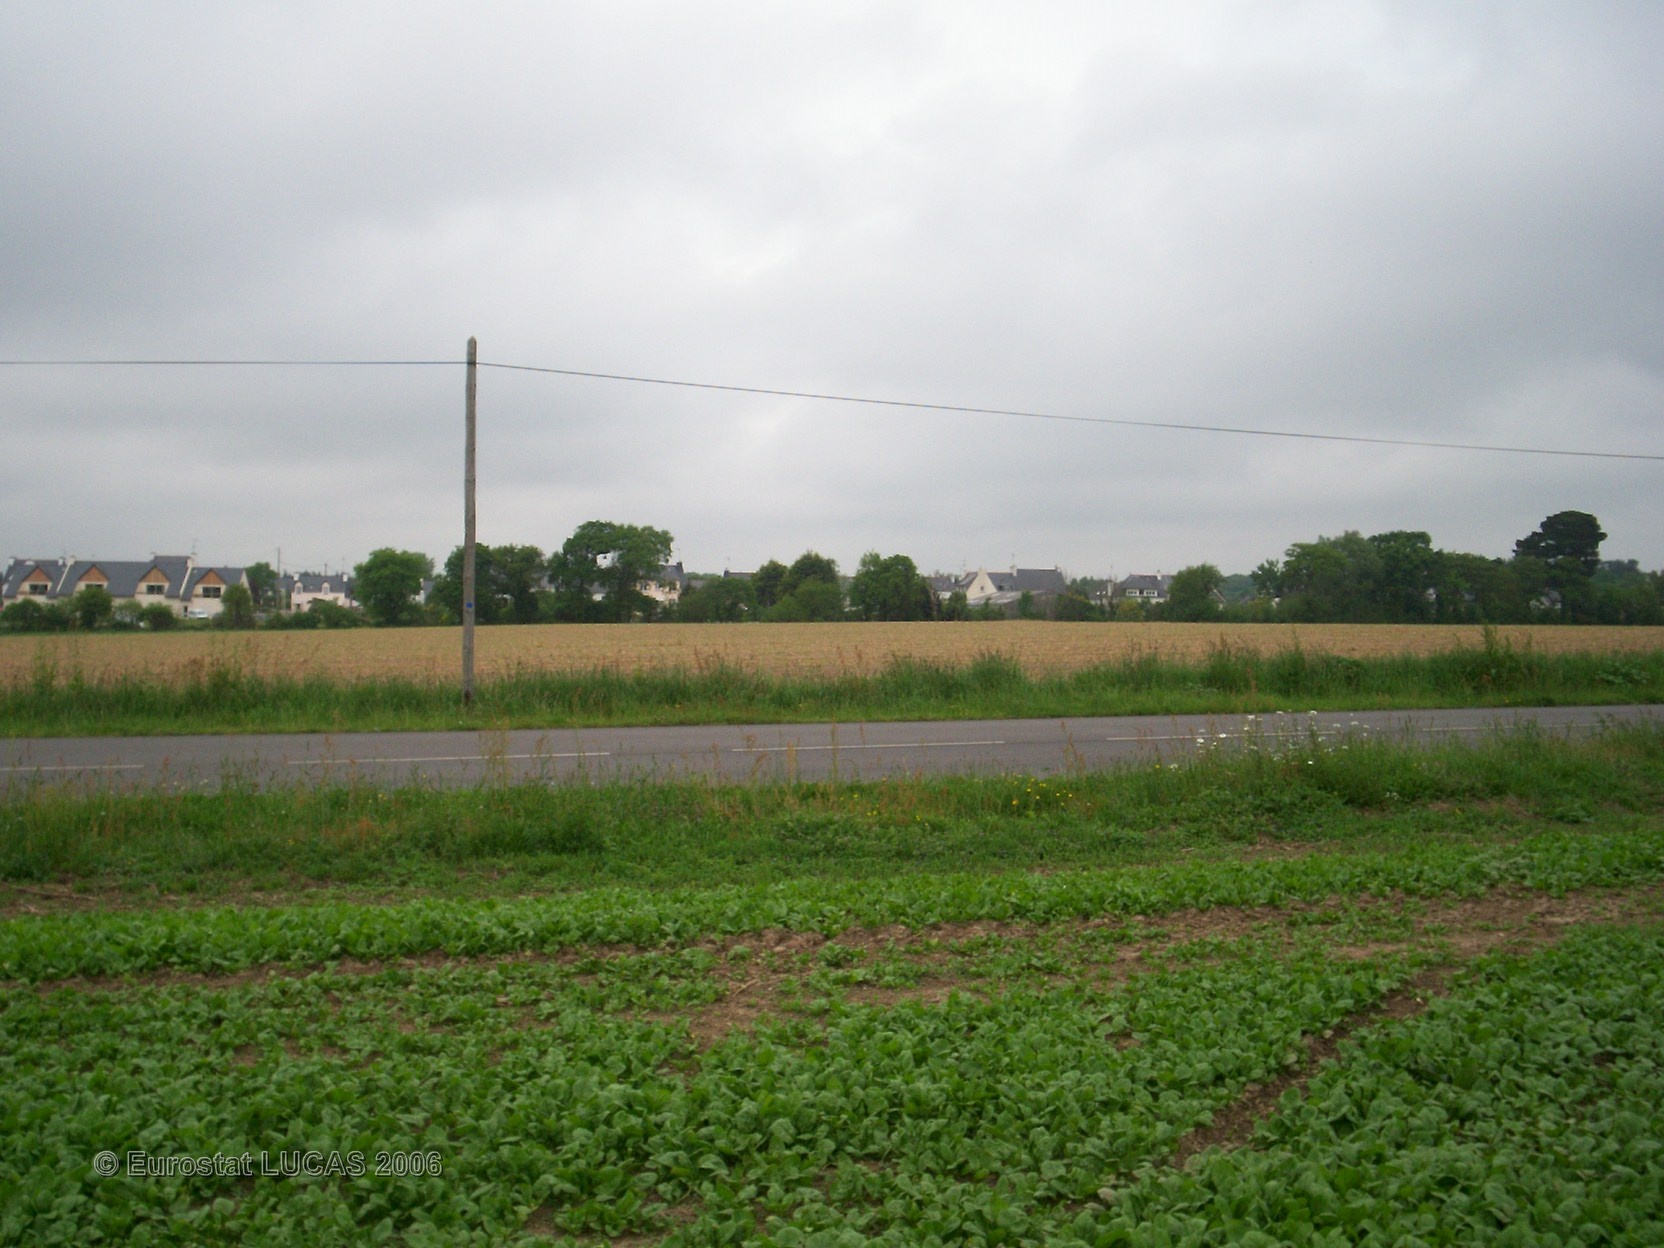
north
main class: Cropland
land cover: Other fresh vegetables
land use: Agriculture (excluding fallow land and kitchen gardens)
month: May
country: FR
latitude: 47.8536
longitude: -3.8619
